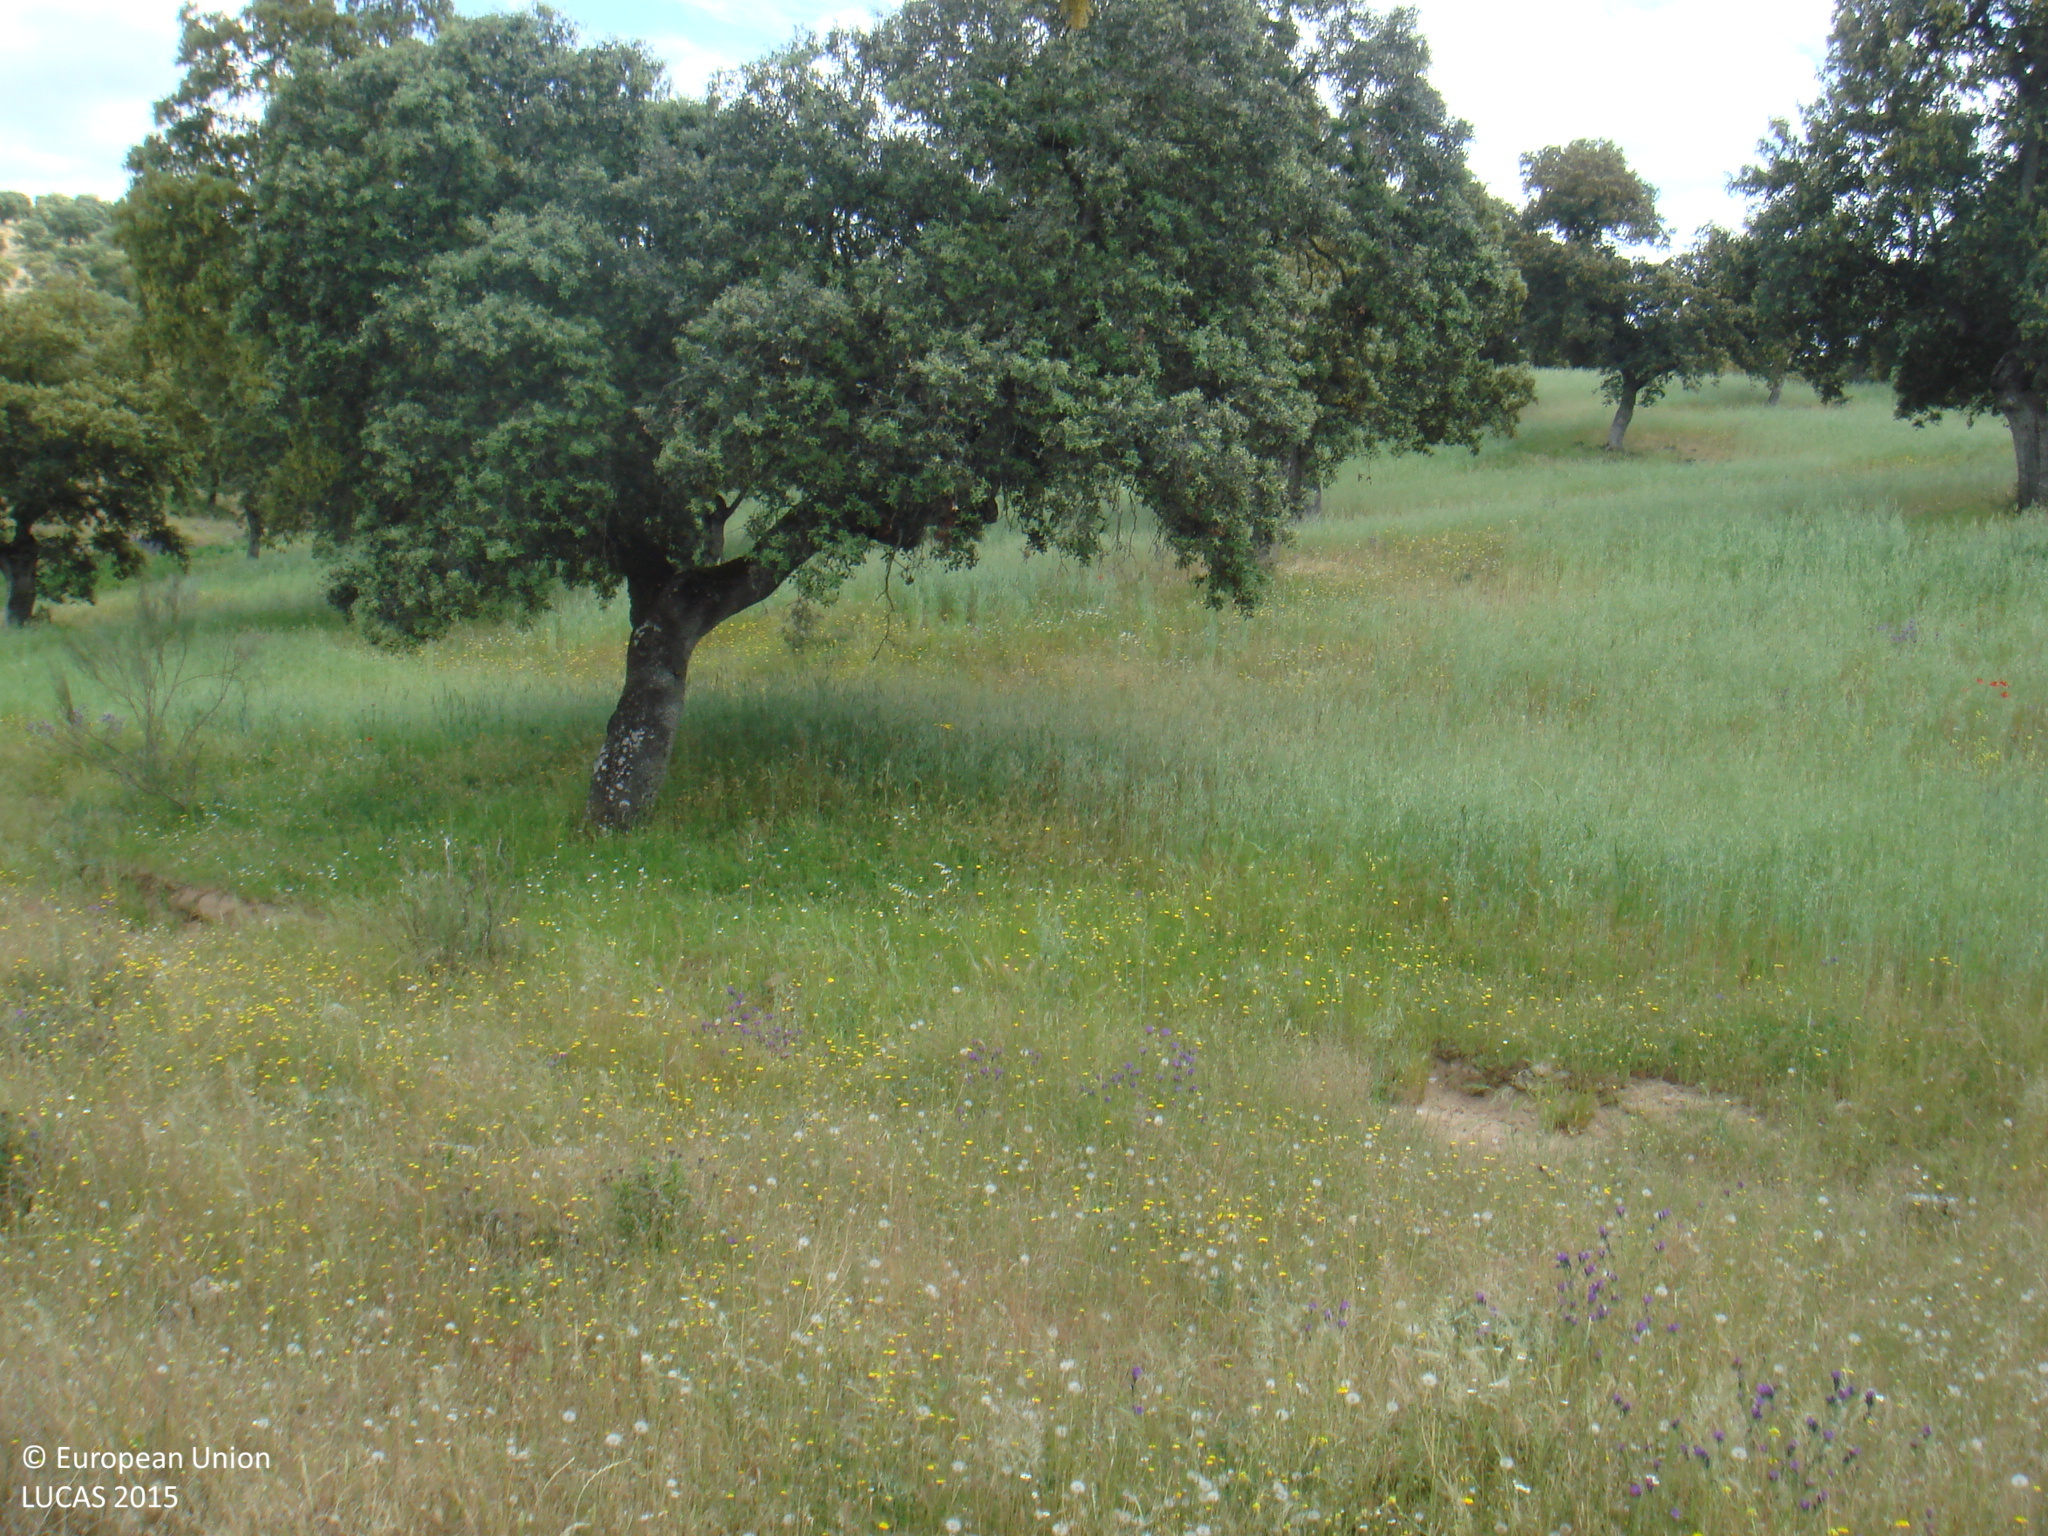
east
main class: Woodland
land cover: Broadleaved woodland
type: broadleaved evergreen forest
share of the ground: 10 - 25 %
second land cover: Spontaneously vegetated surfaces
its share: 50 - 75 %
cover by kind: herbaceous plants 70 %, broadleaved forest trees 20 %, shrubs 10 %
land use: Forestry
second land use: Agriculture (excluding fallow land and kitchen gardens)
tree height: > 5 m
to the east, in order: Broadleaved woodland; Spontaneously vegetated surfaces; Rivers and streams; Broadleaved woodland; Rivers and streams; Broadleaved woodland; Fences; Shrubland with sparse tree cover
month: May
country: ES
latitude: 38.4053
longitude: -4.6676
